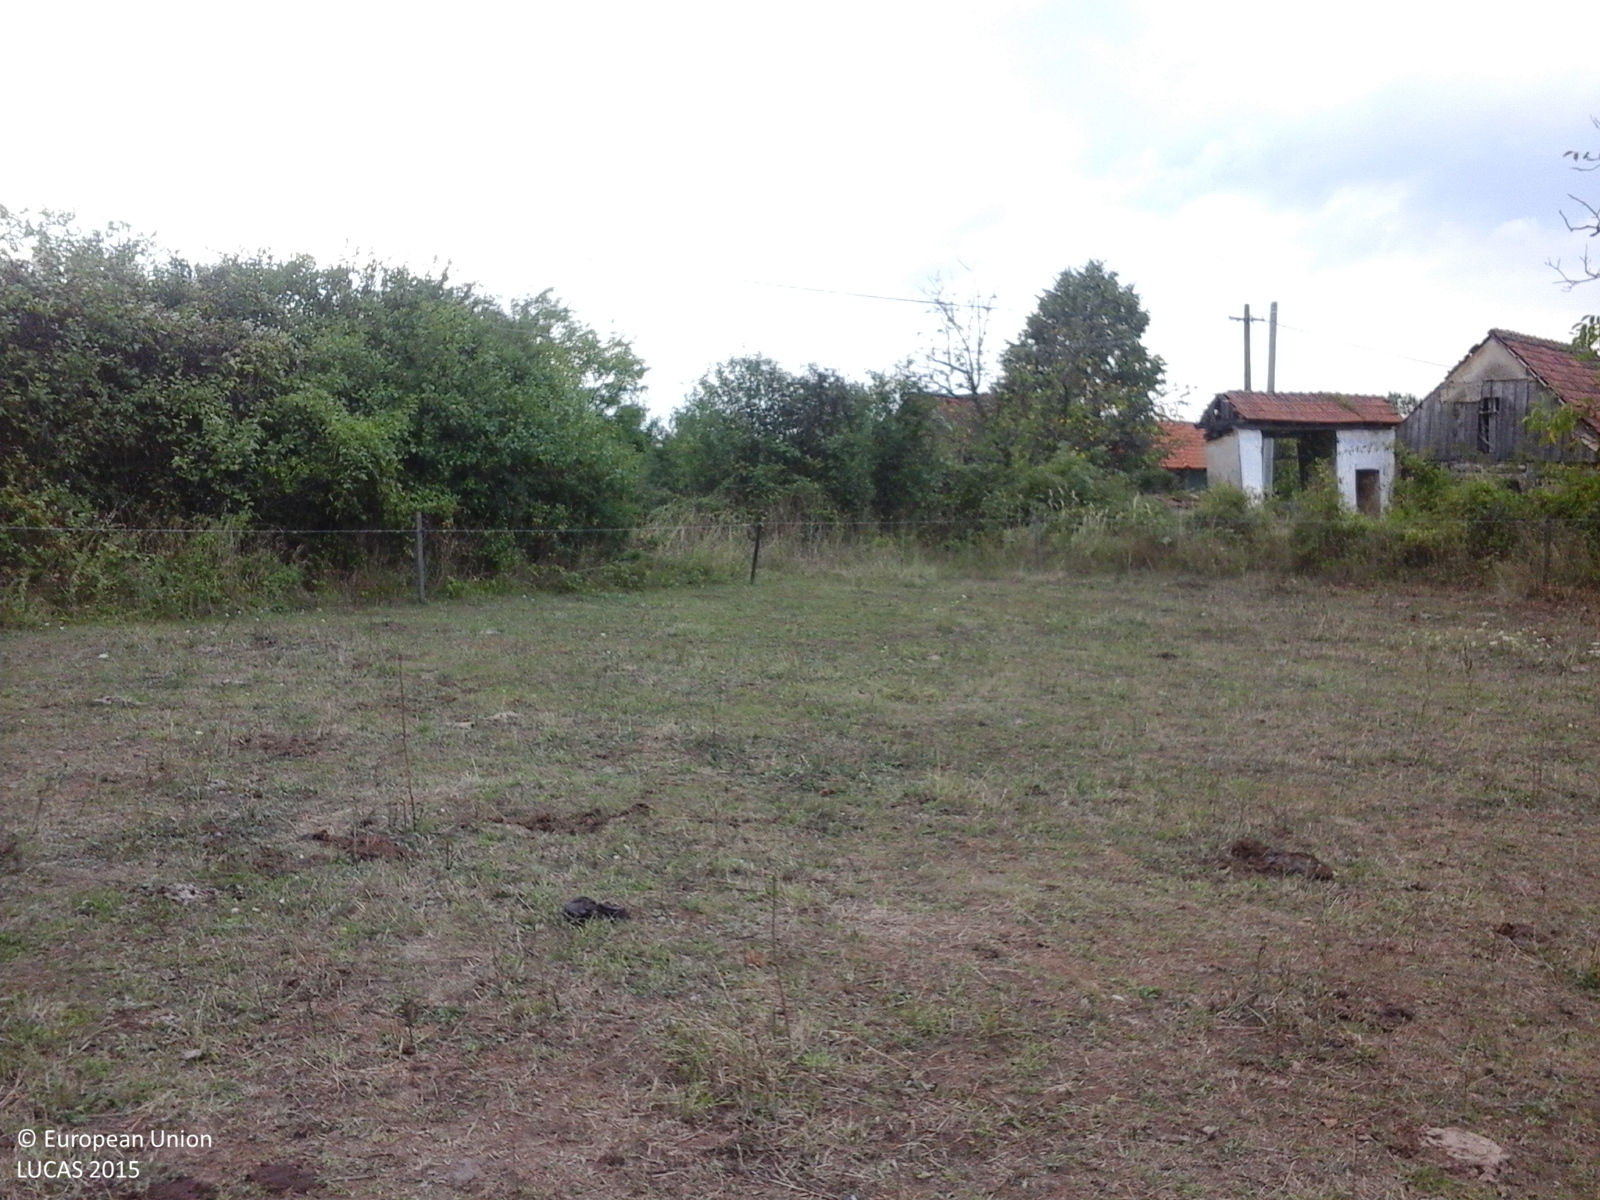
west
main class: Grassland
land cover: Grassland without tree/shrub cover
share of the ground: > 75 %
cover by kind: herbaceous plants 100 %
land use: Agriculture (excluding fallow land and kitchen gardens)
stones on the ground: < 10 %
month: August
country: RO
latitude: 45.4659
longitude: 21.7377
